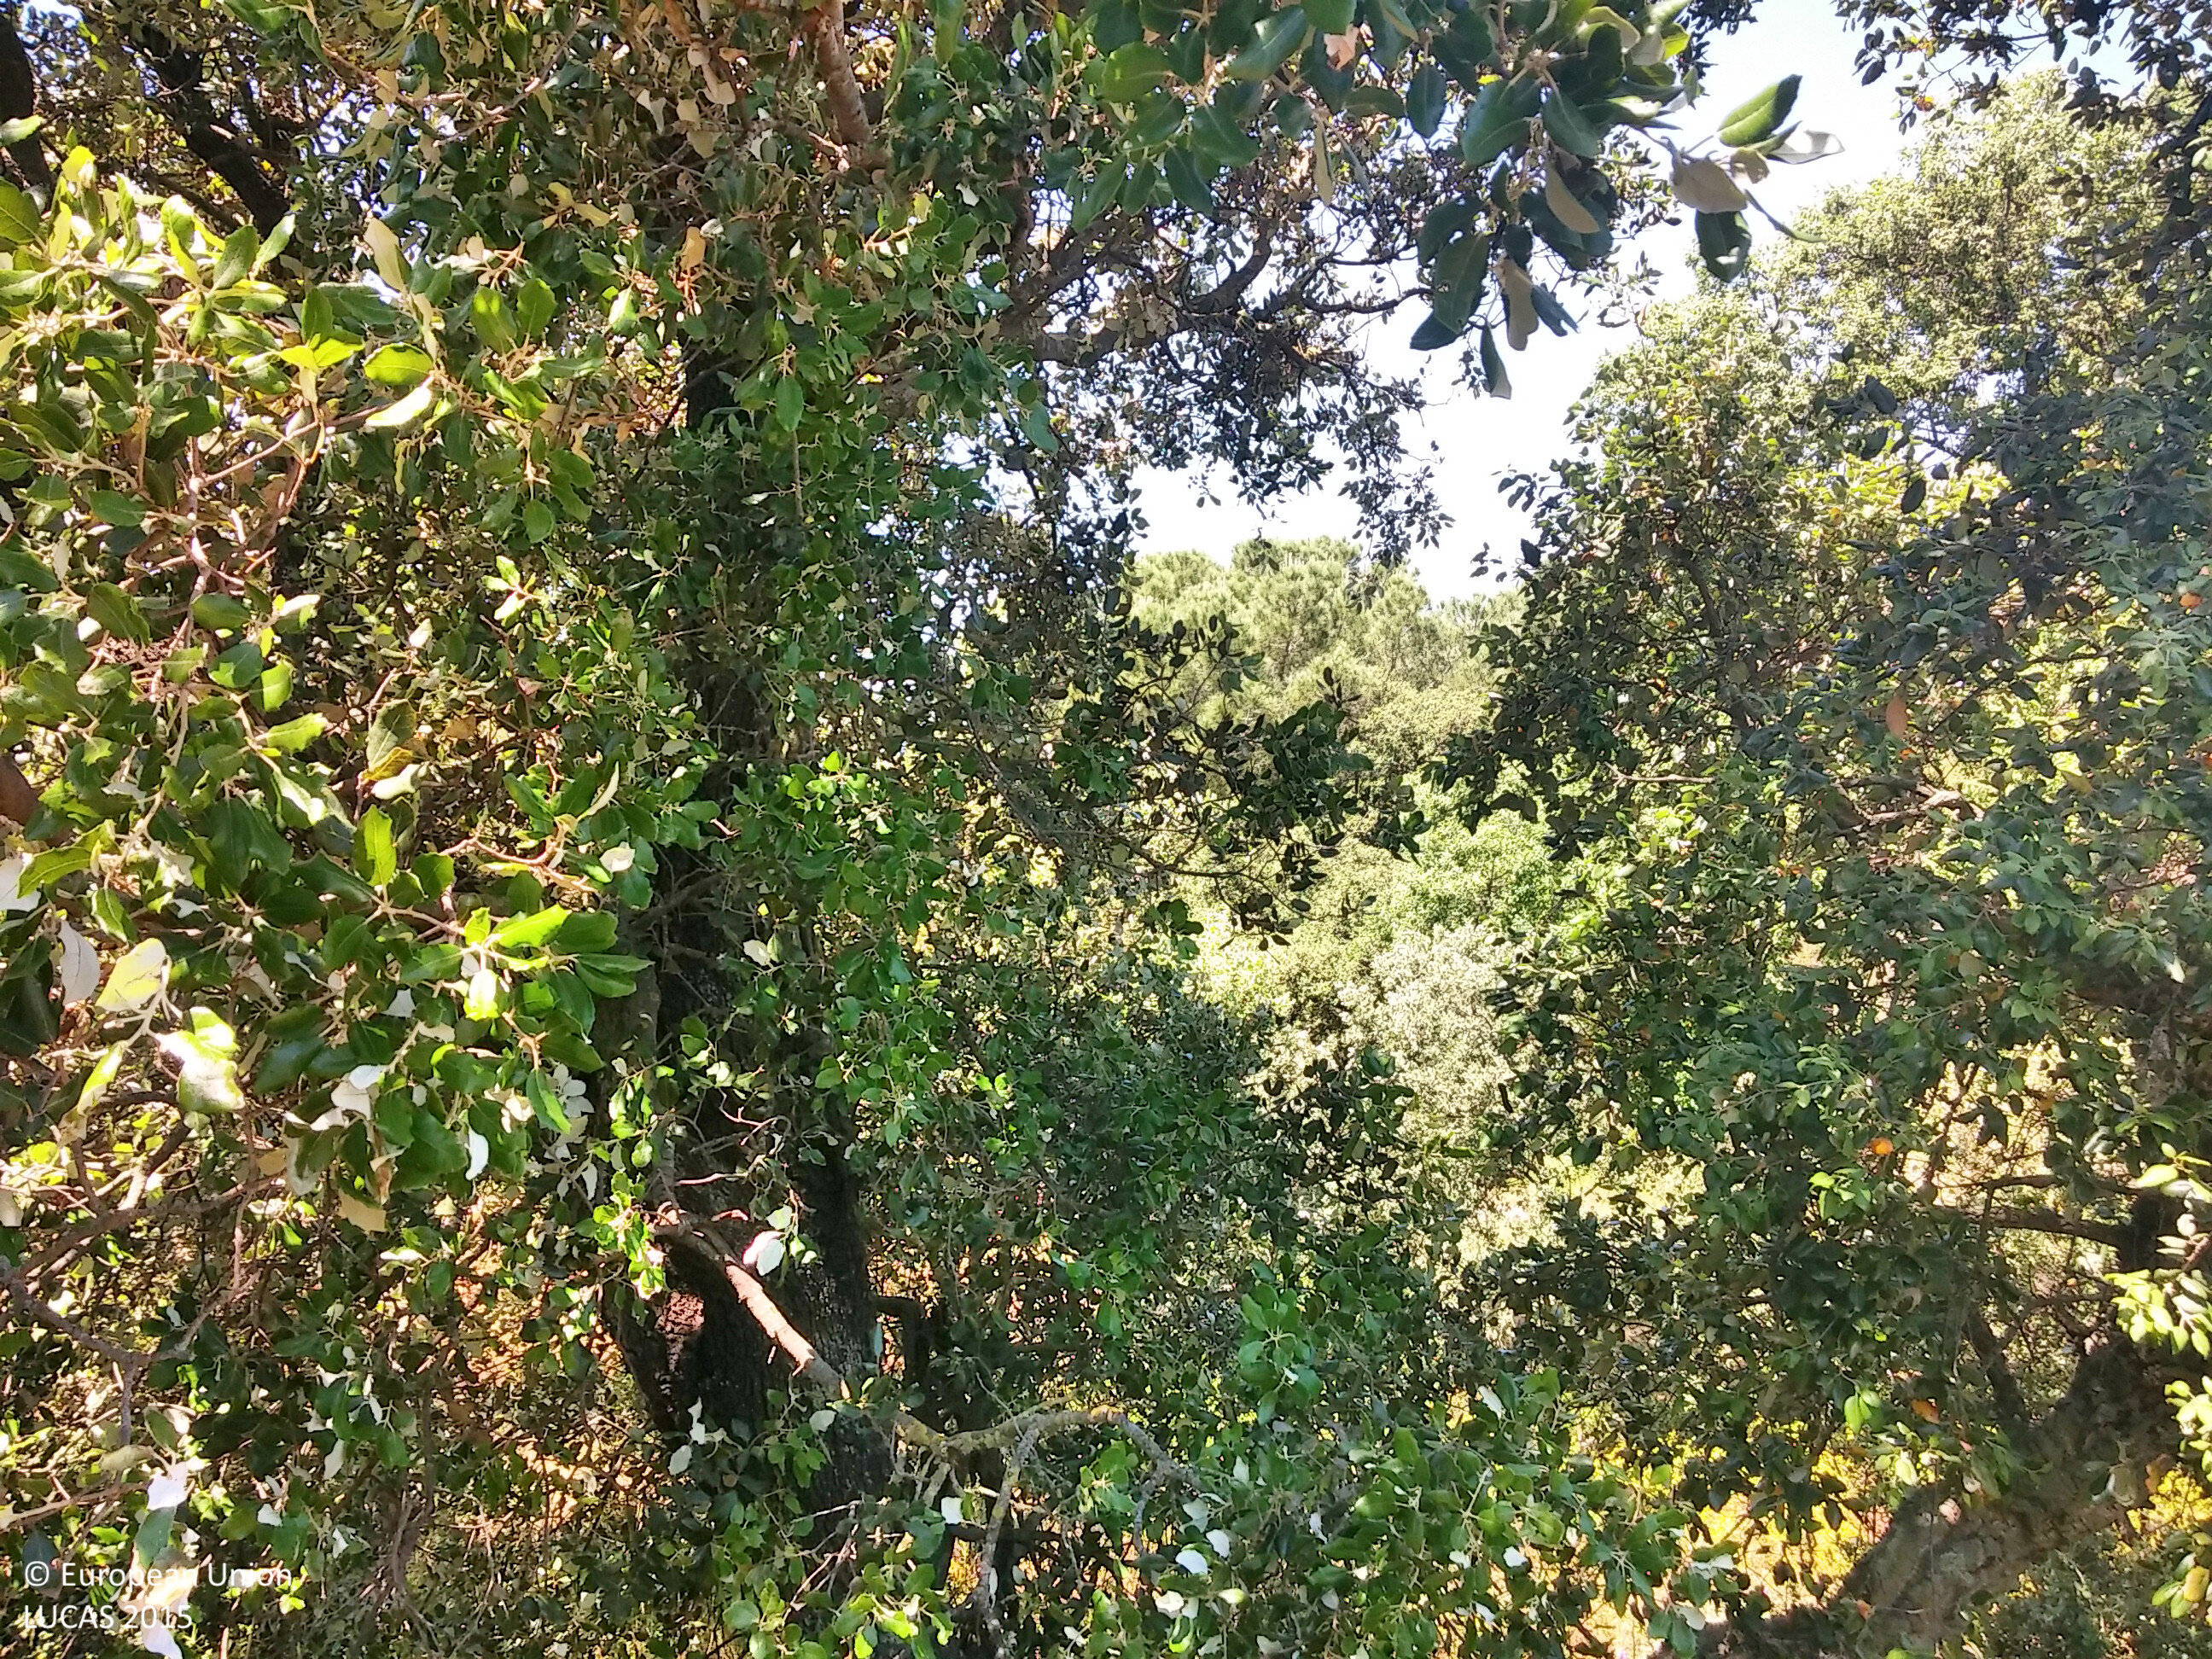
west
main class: Woodland
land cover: Broadleaved woodland
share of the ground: 25 - 50 %
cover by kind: herbaceous plants 55 %, broadleaved forest trees 35 %, shrubs 10 %
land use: Forestry
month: May
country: ES
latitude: 42.3545
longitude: 2.9602
